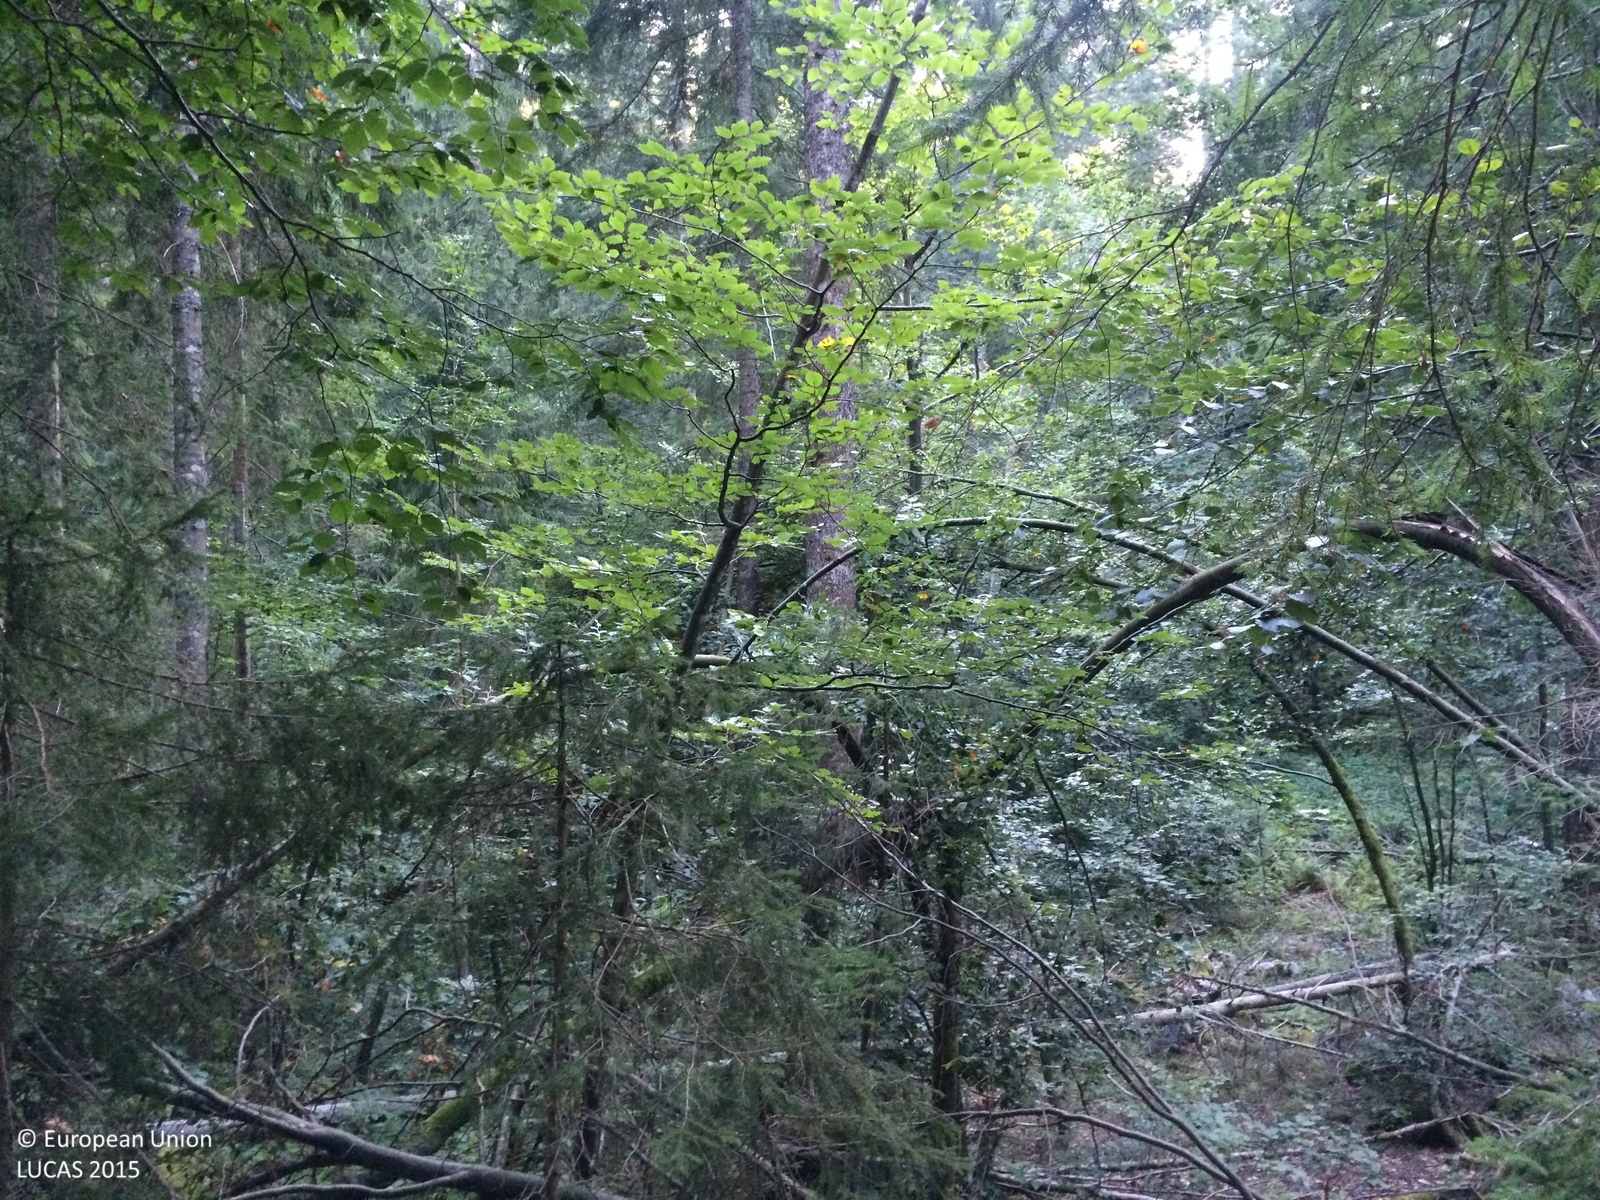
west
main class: Woodland
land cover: Other mixed woodland
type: mountainous beech forest
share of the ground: > 75 %
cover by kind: broadleaved forest trees 75 %, coniferous forest trees 25 %
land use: Forestry
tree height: > 5 m
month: September
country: HR
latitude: 45.5668
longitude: 14.5953
